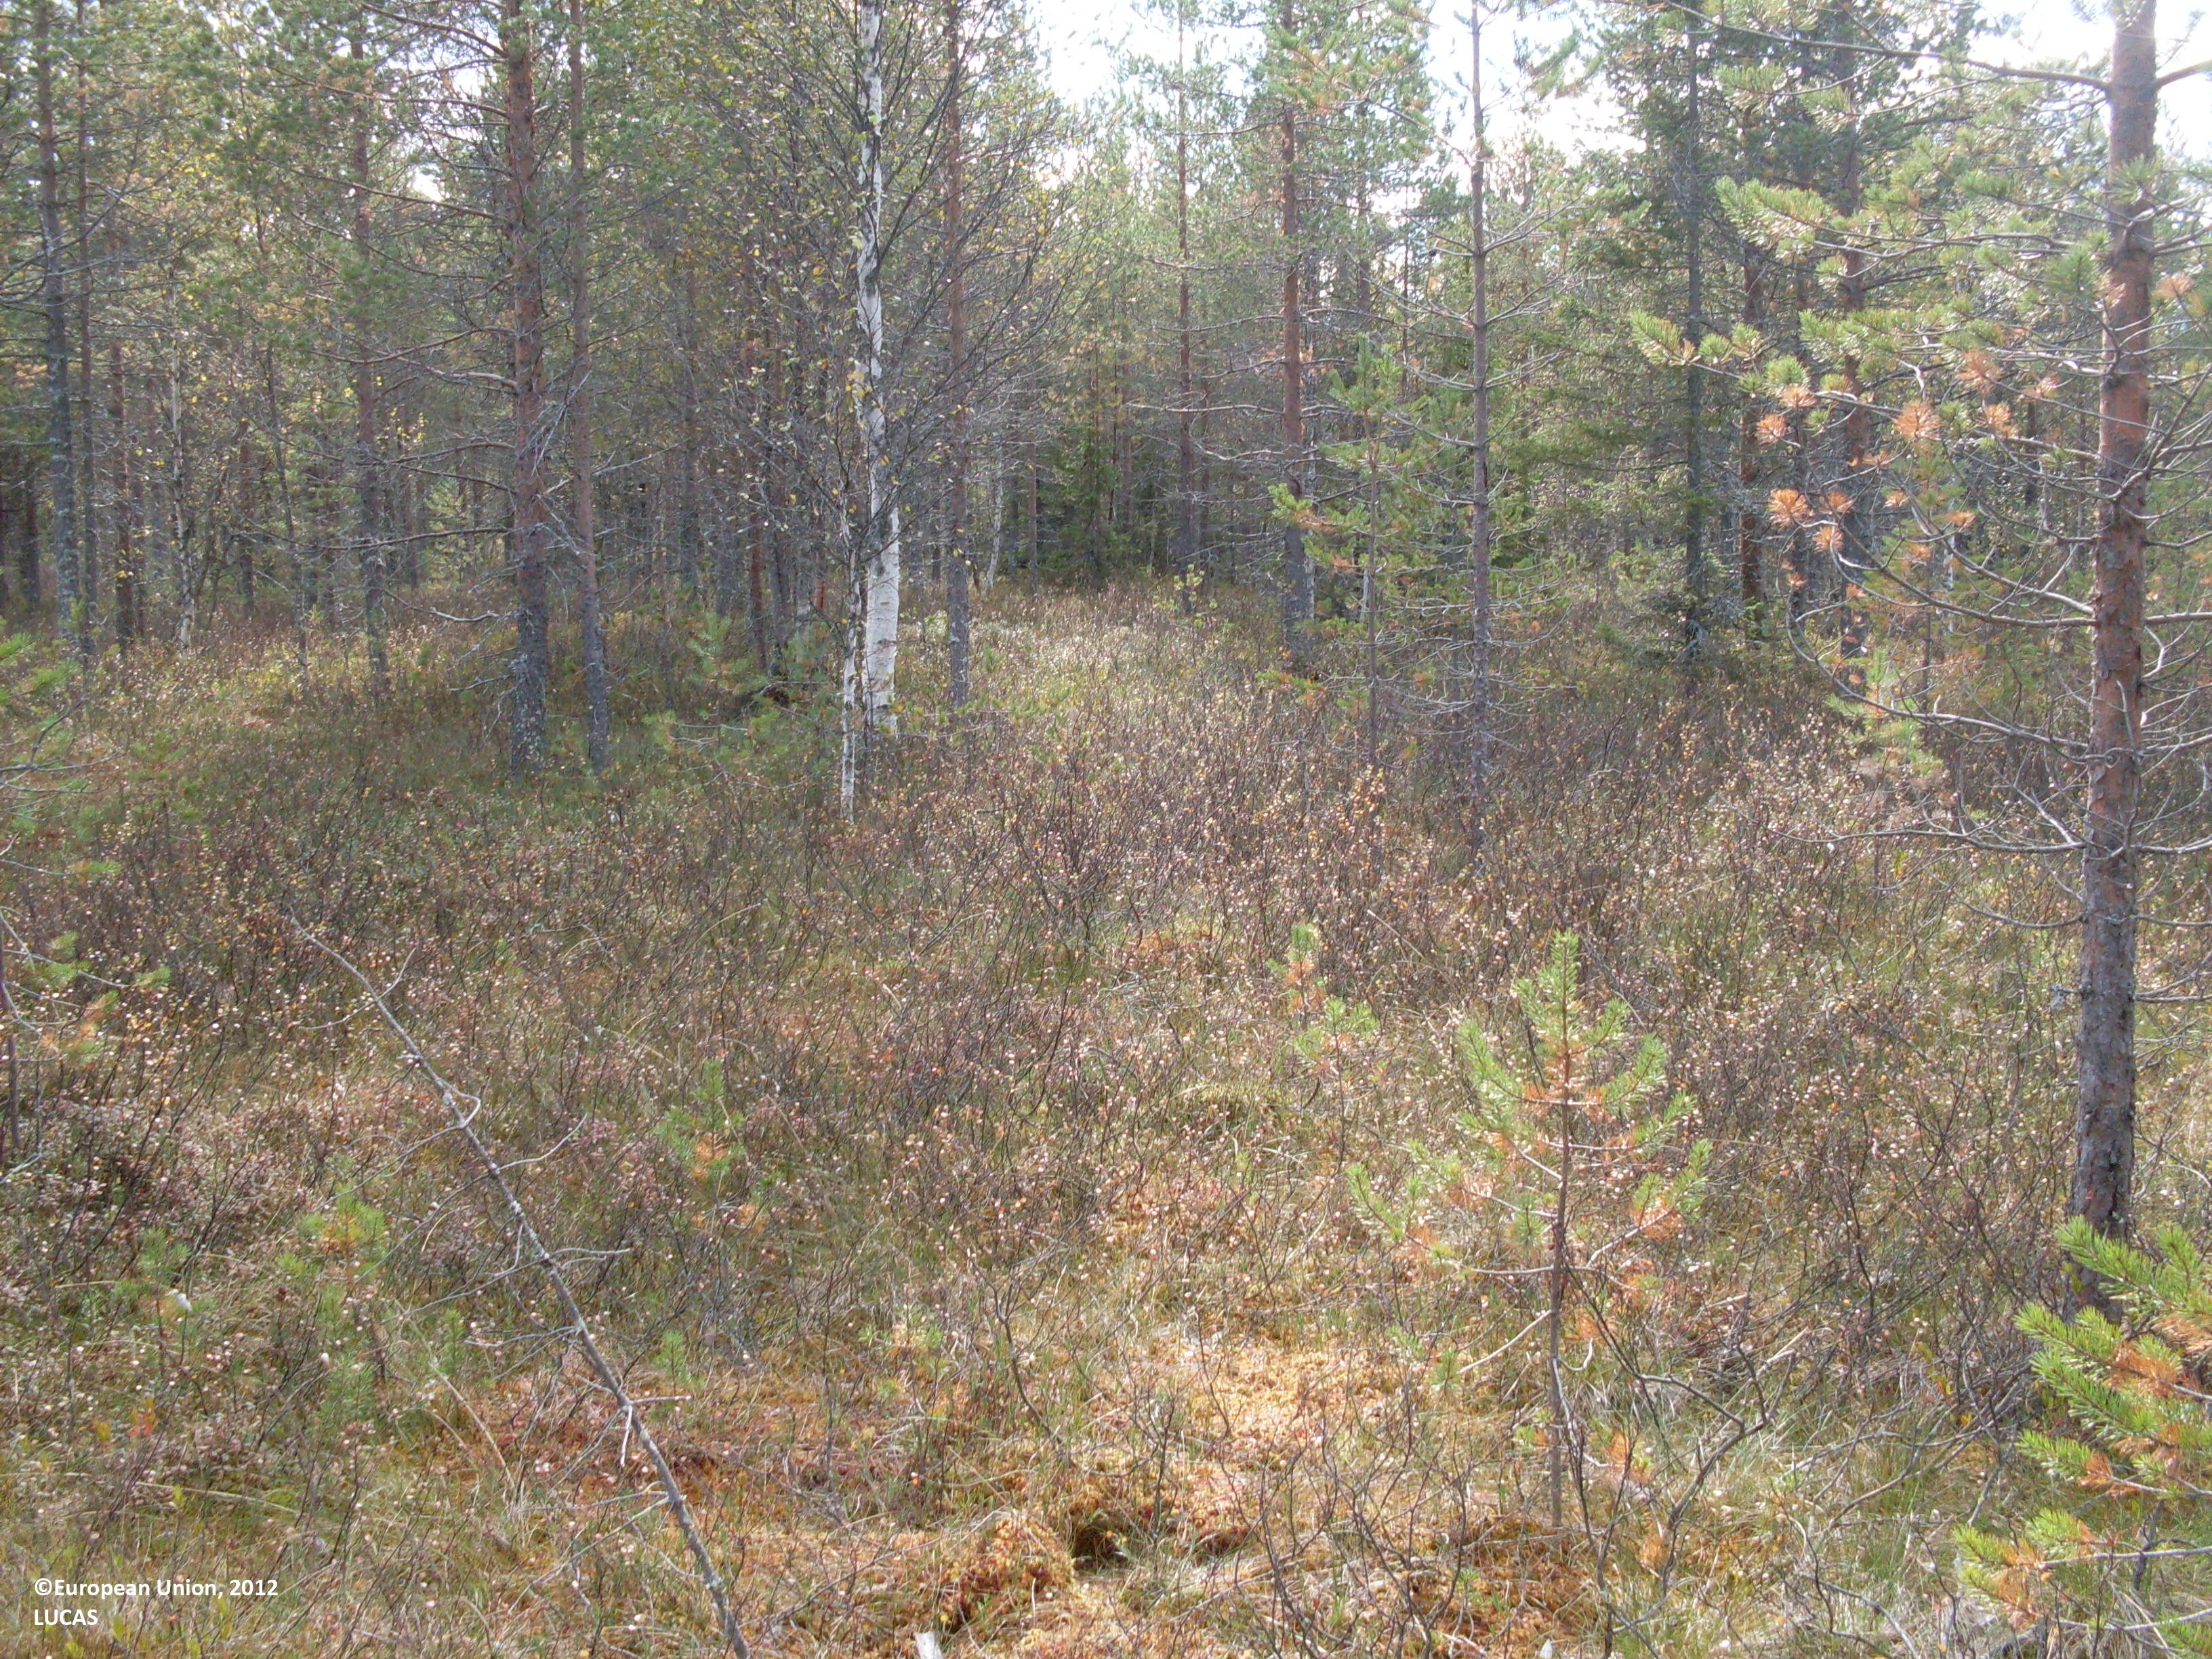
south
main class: Woodland
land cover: Pine dominated coniferous woodland
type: boreal forest
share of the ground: 25 - 50 %
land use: Forestry
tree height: > 5 m
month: September
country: FI
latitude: 64.1900
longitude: 30.1512
